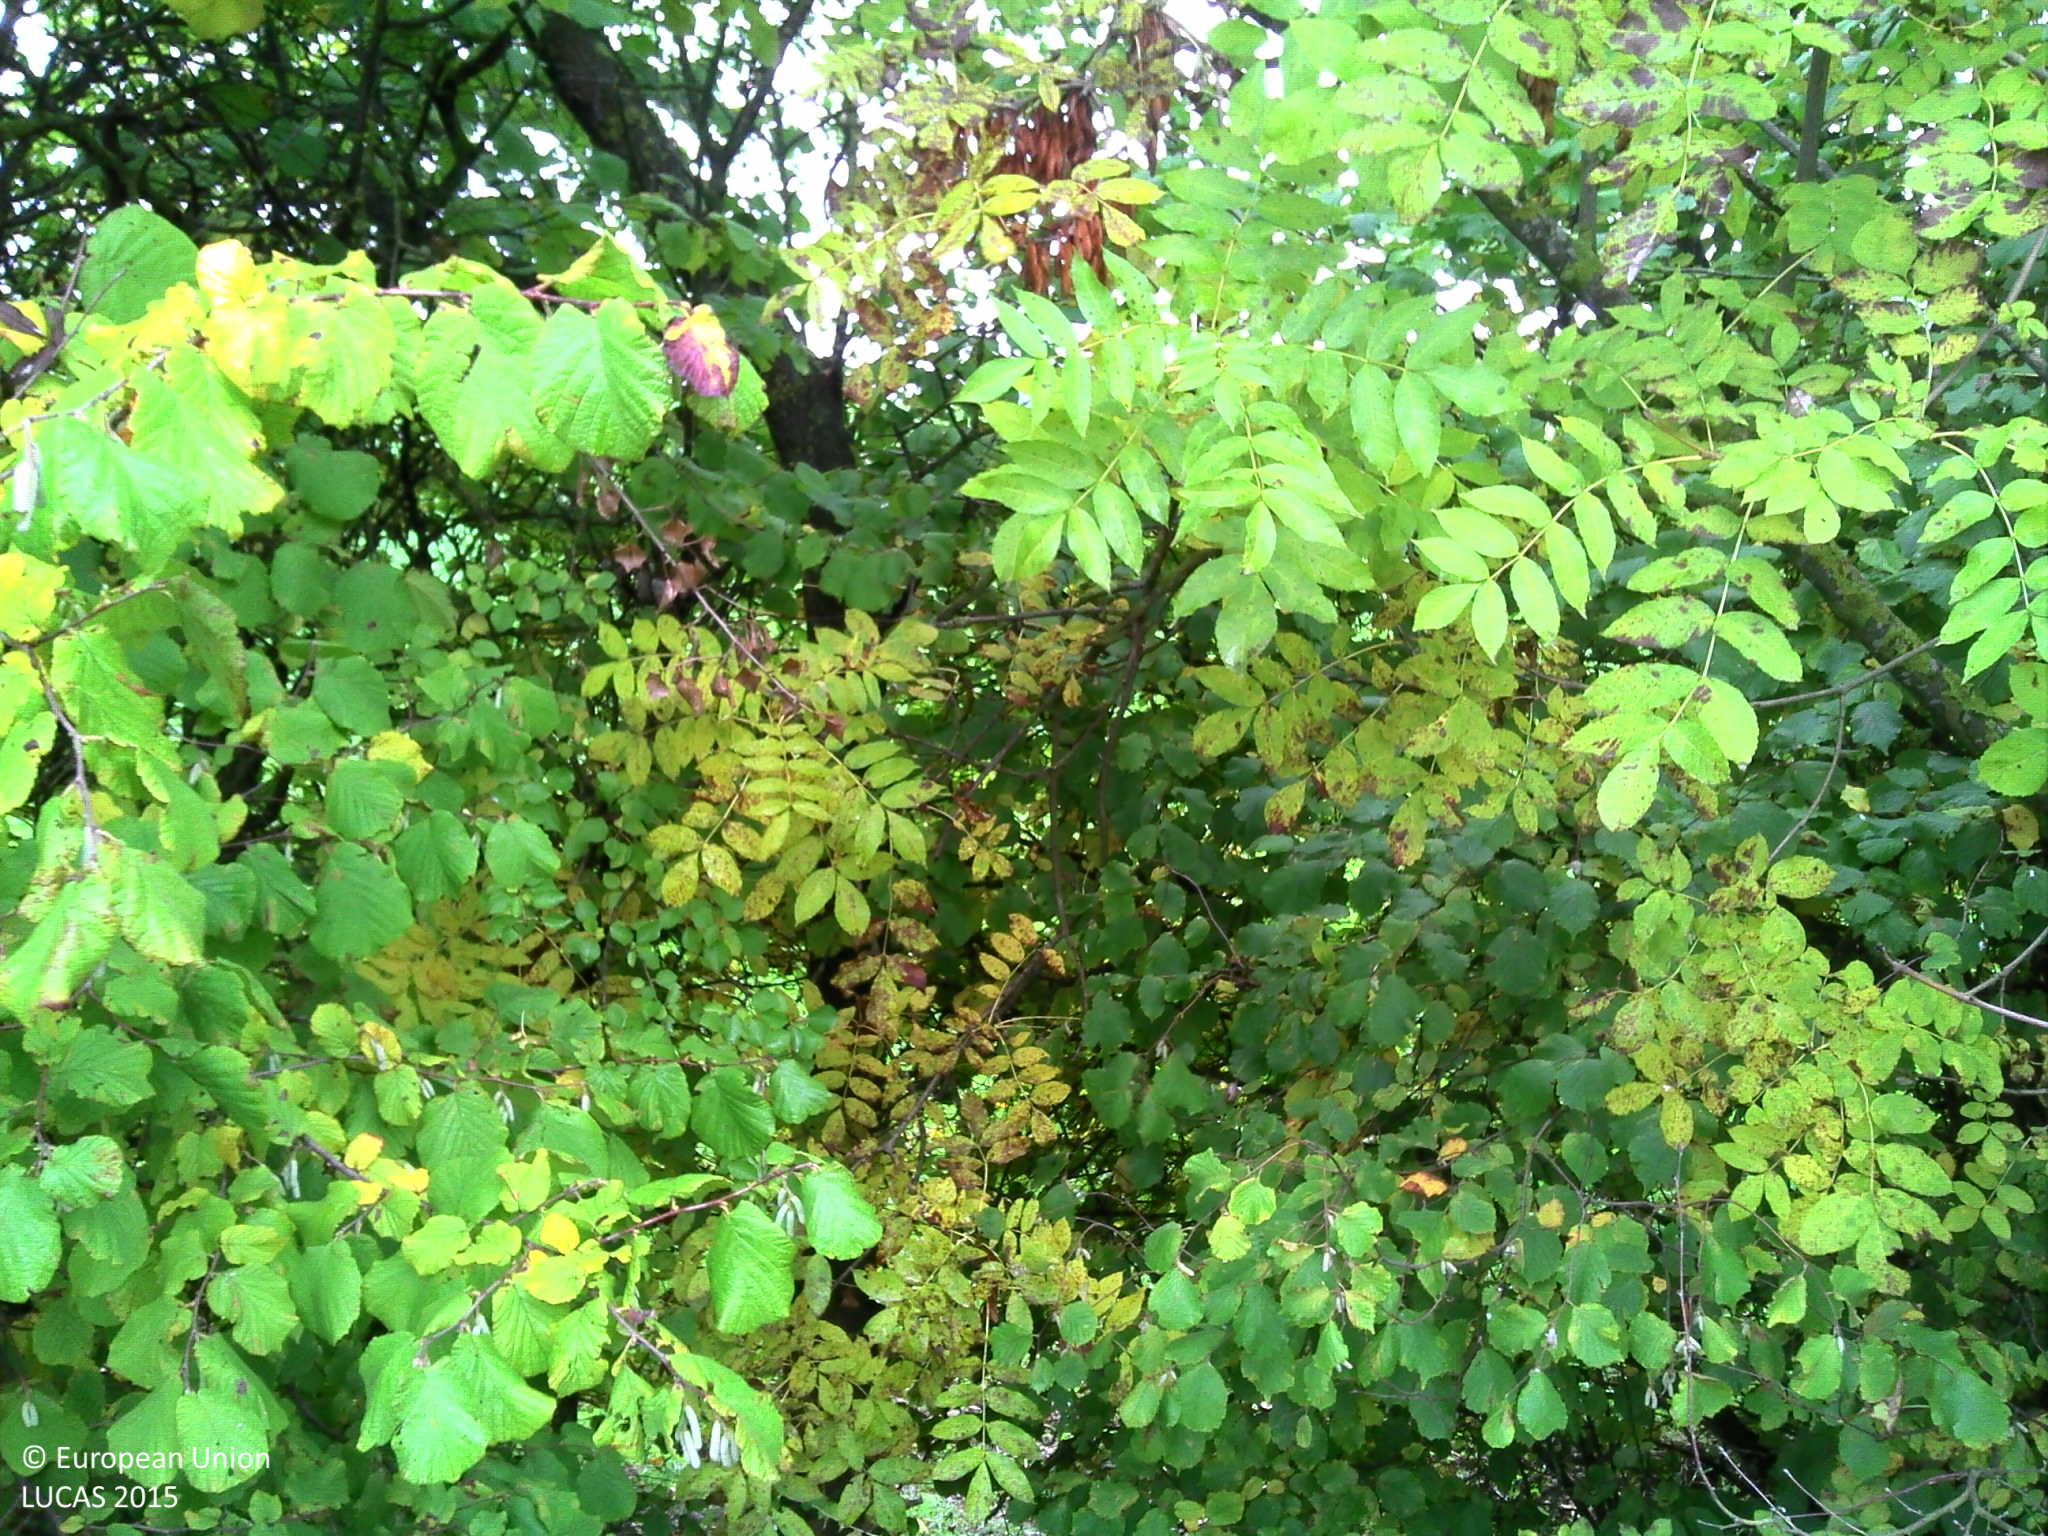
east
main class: Cropland
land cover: Other fibre and oleaginous crops
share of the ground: 50 - 75 %
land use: Agriculture (excluding fallow land and kitchen gardens)
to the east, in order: Grass margins; Abandoned hedges; Other fibre and oleaginous crops; Tracks; Grass margins; Other fibre and oleaginous crops
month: October
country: FR
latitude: 48.8278
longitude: 1.8801
